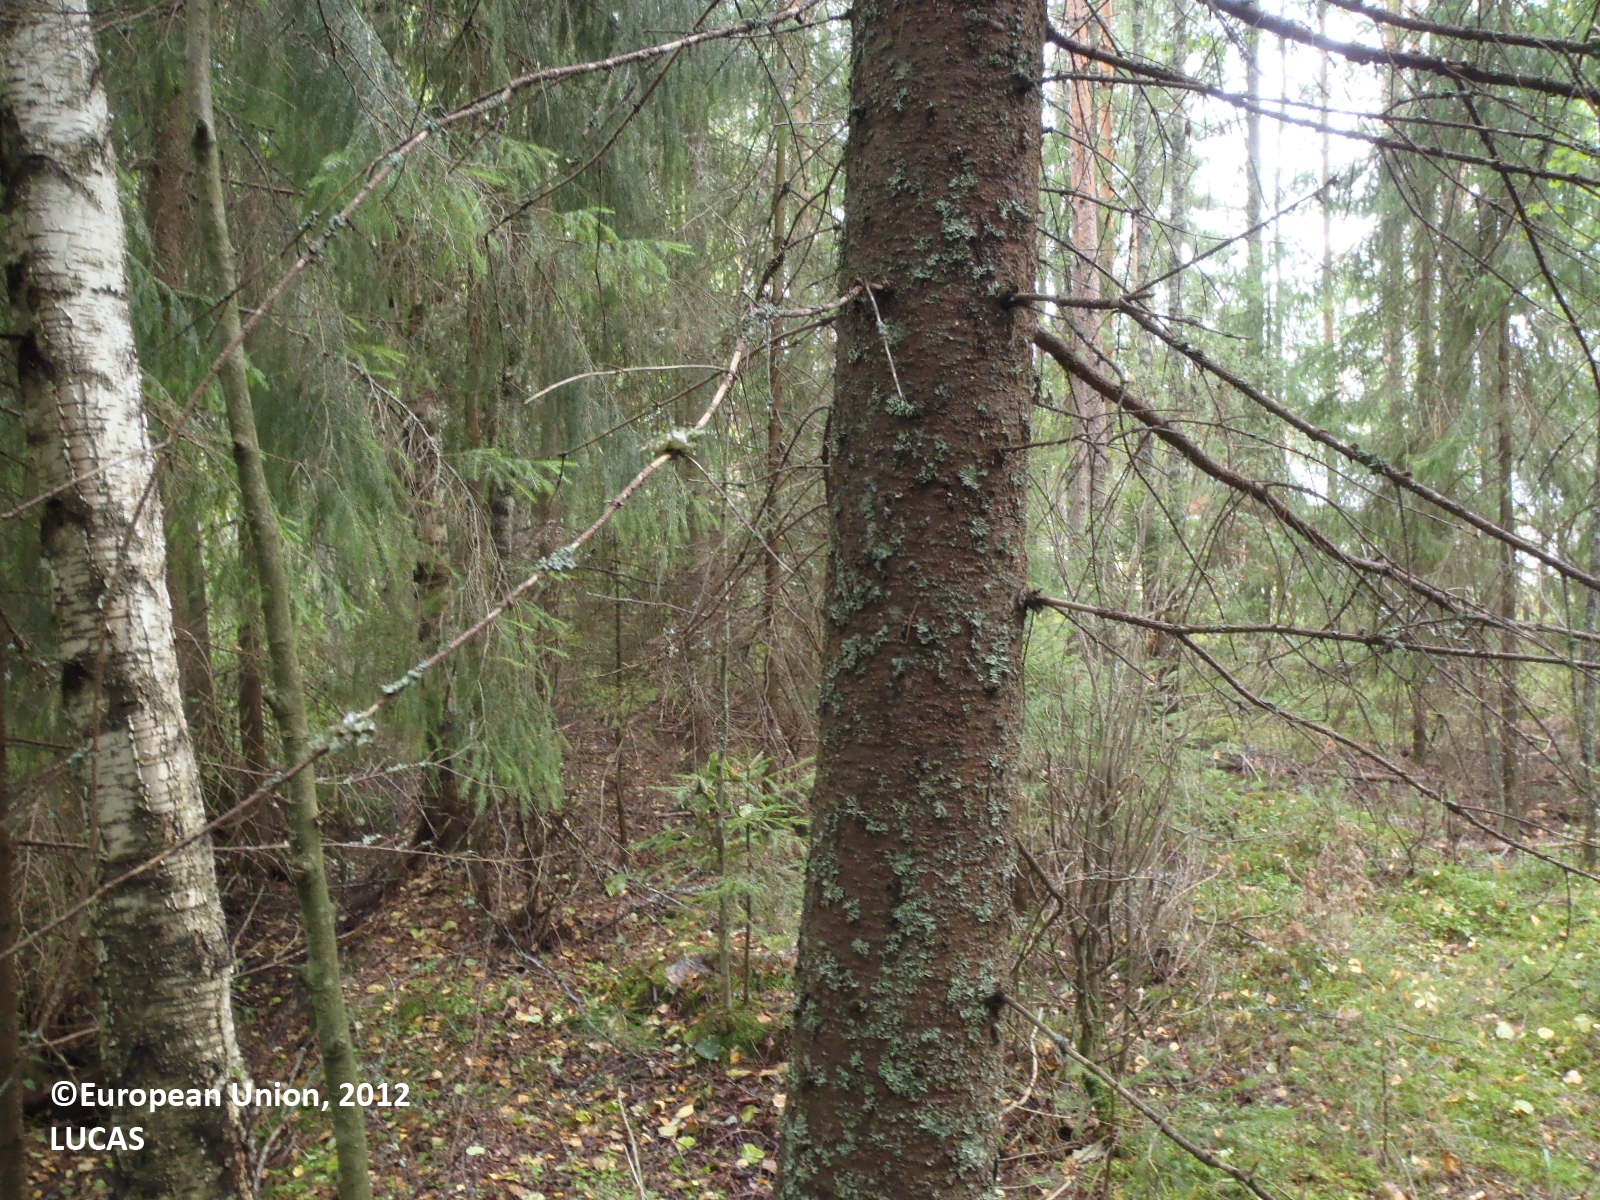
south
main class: Woodland
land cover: Pine dominated mixed woodland
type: boreal forest
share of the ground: > 75 %
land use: Forestry
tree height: > 5 m
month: September
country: FI
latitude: 60.7439
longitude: 22.8223
